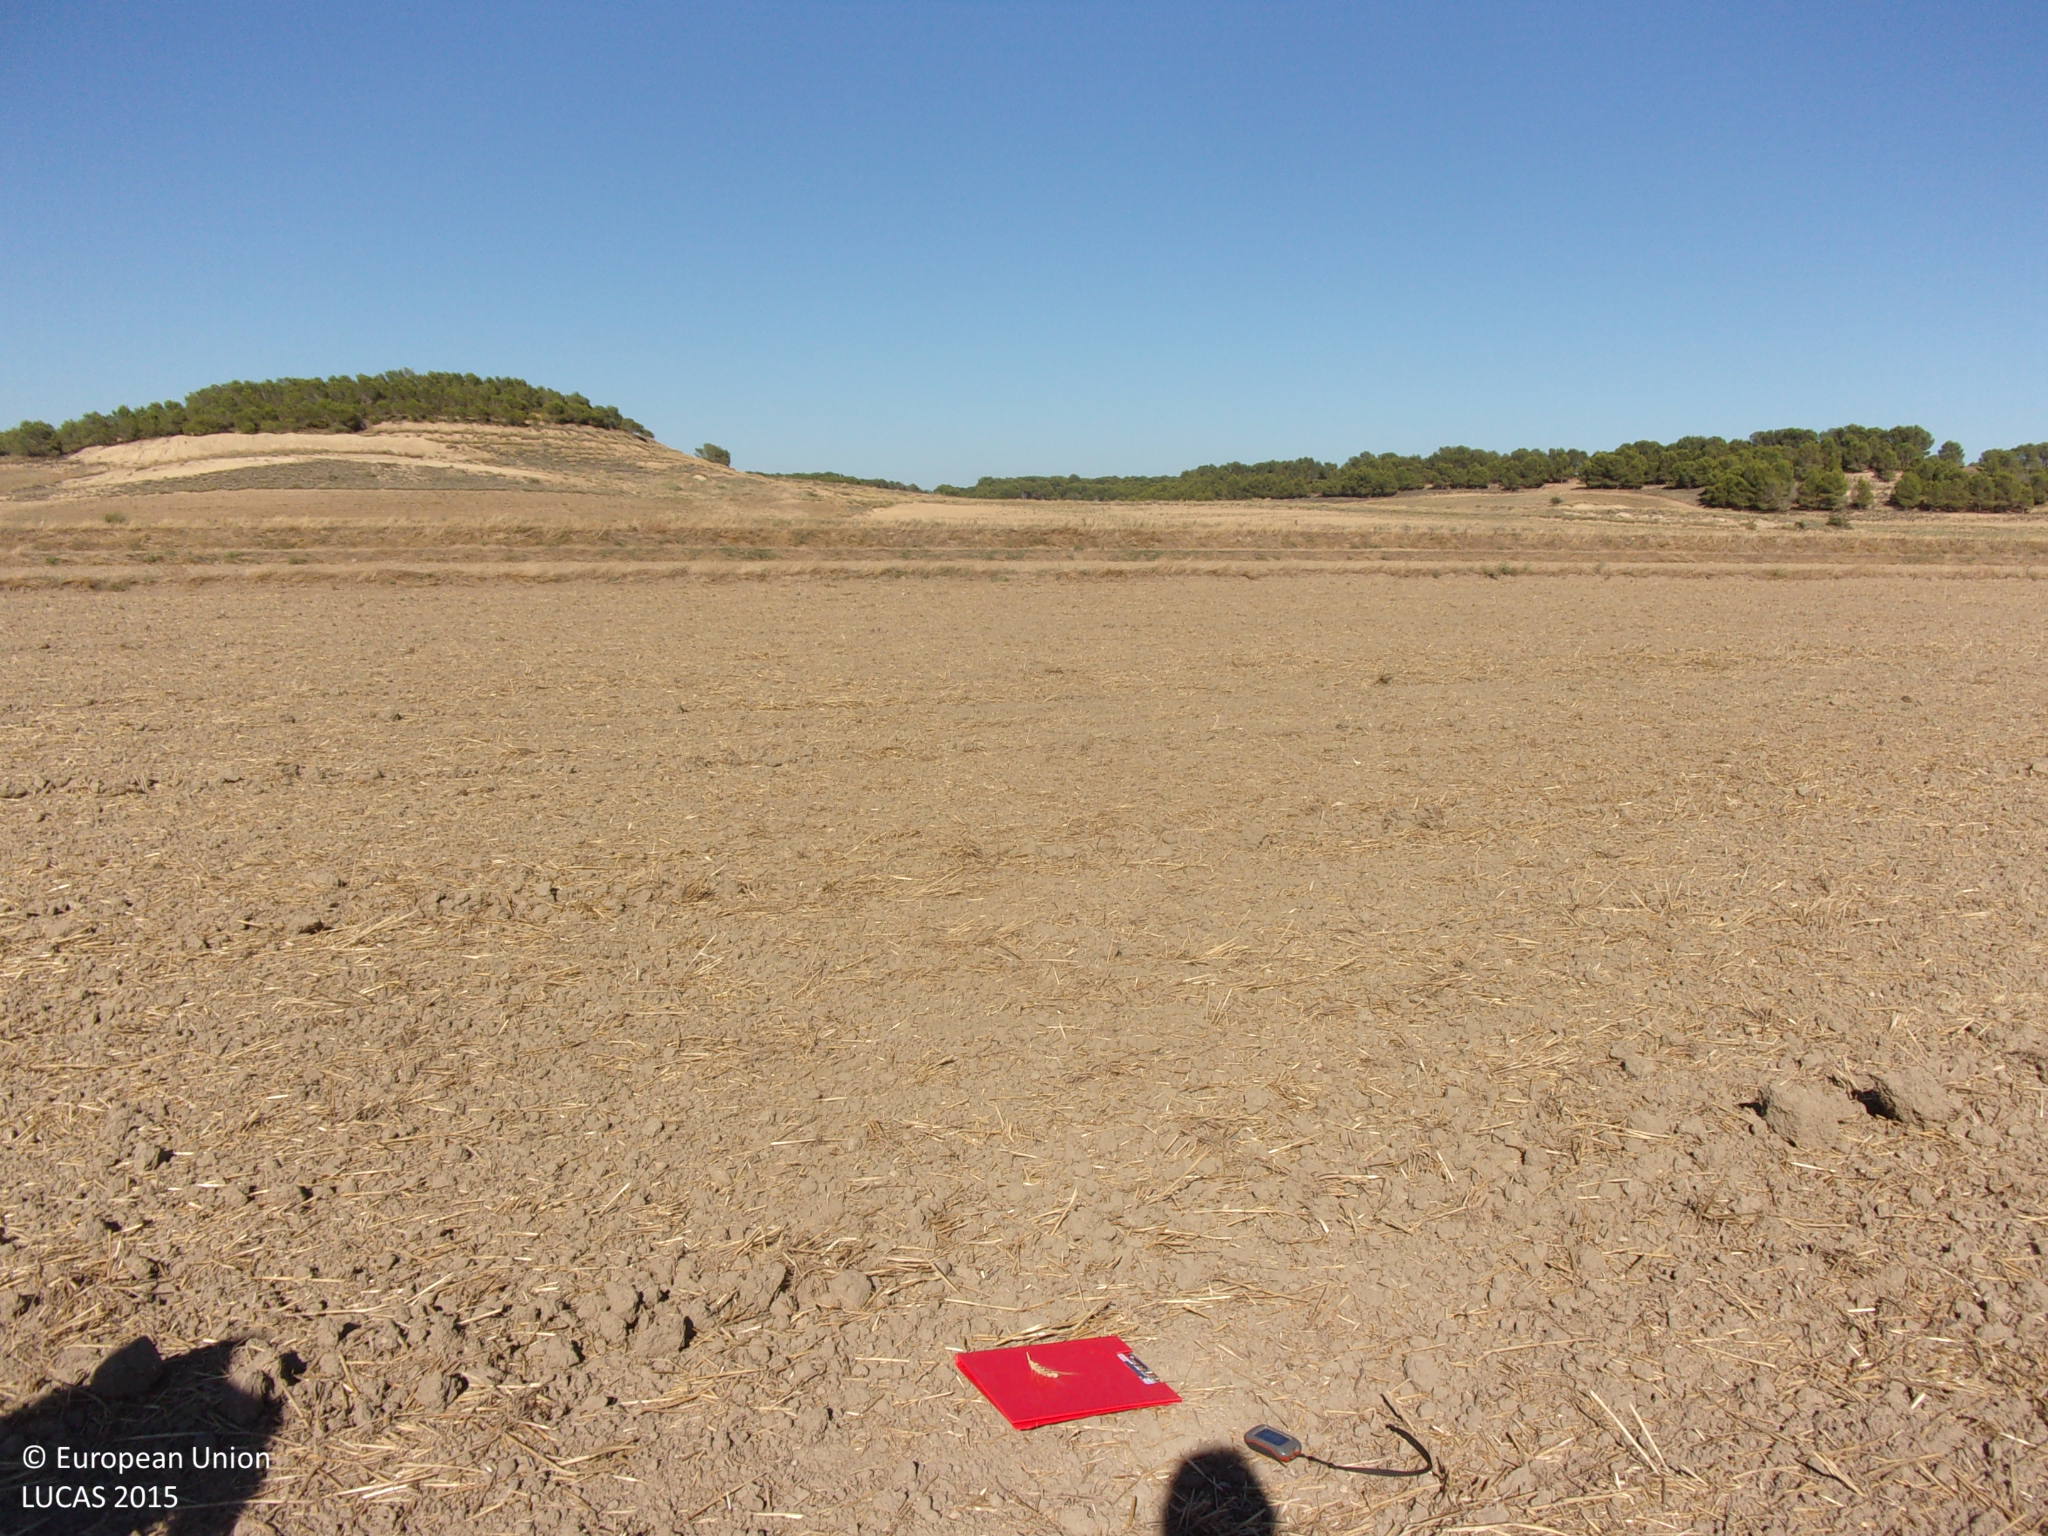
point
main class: Cropland
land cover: Common wheat
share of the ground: < 10 %
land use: Agriculture (excluding fallow land and kitchen gardens)
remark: Harvested field
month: August
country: ES
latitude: 42.1957
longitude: -1.3535
